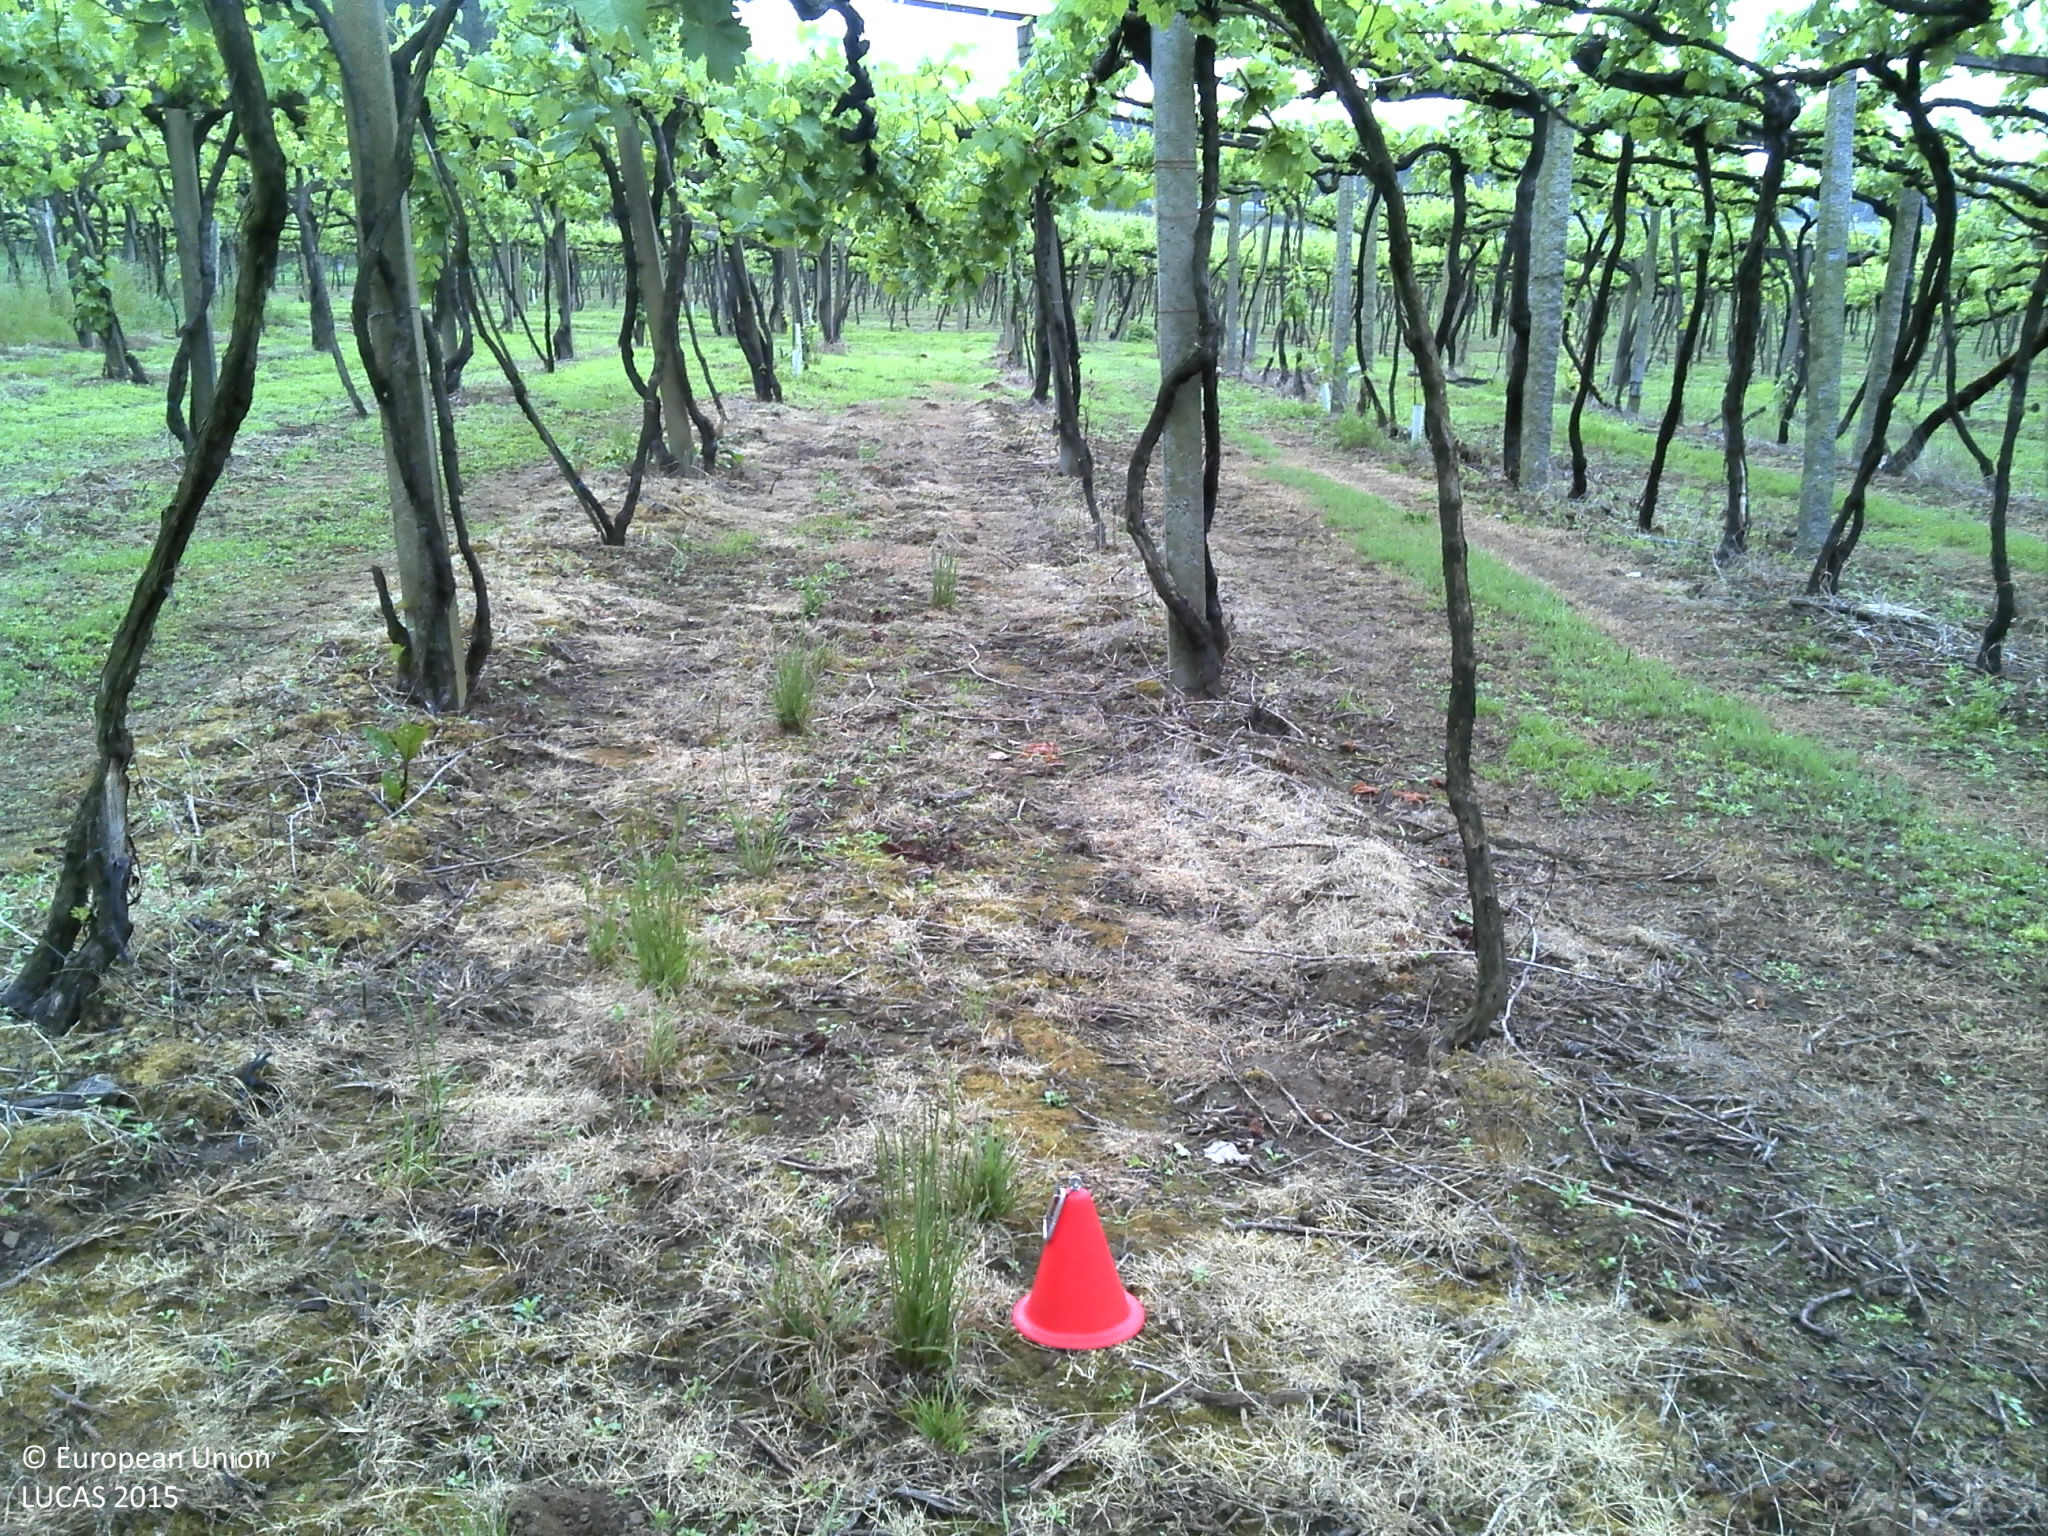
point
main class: Cropland
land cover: Vineyards
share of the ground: 50 - 75 %
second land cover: Grassland without tree/shrub cover
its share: 10 - 25 %
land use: Agriculture (excluding fallow land and kitchen gardens)
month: May
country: PT
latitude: 41.1997
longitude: -8.4530
